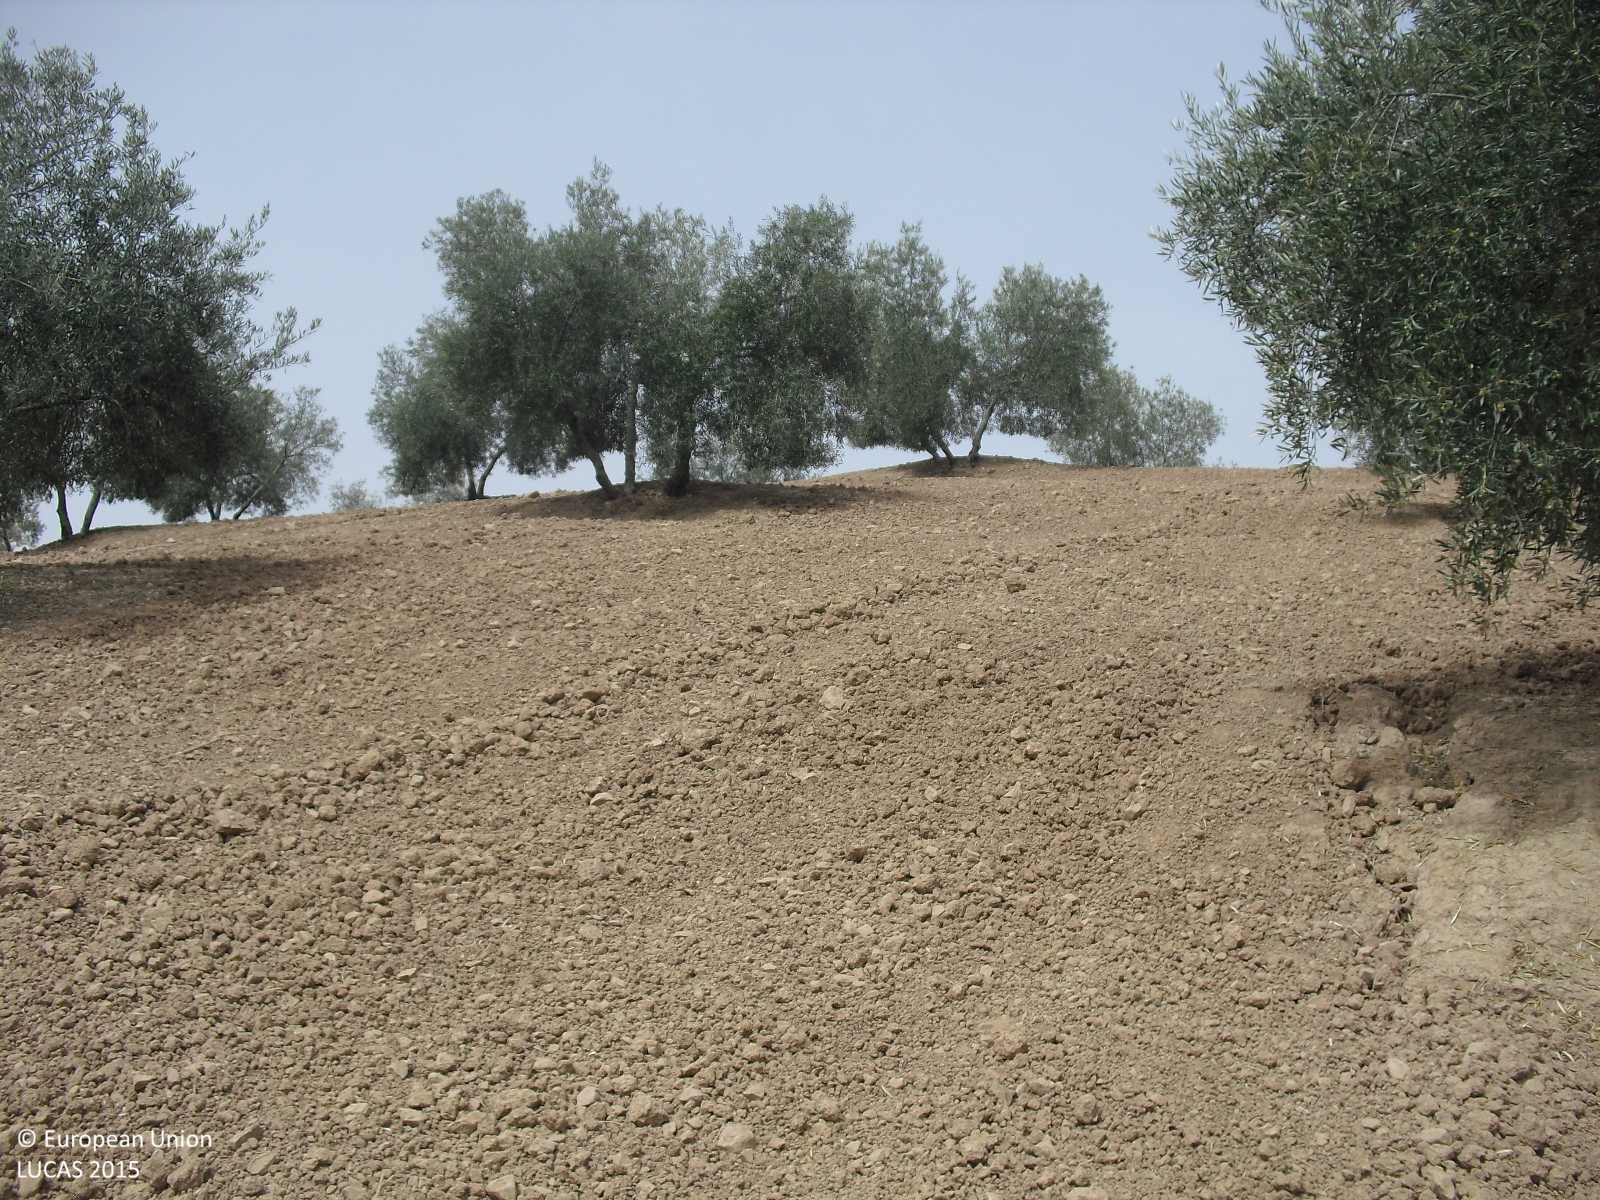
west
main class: Cropland
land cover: Olive groves
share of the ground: 25 - 50 %
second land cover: Other bare soil
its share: > 75 %
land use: Agriculture (excluding fallow land and kitchen gardens)
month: August
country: ES
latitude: 37.2094
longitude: -4.3188
